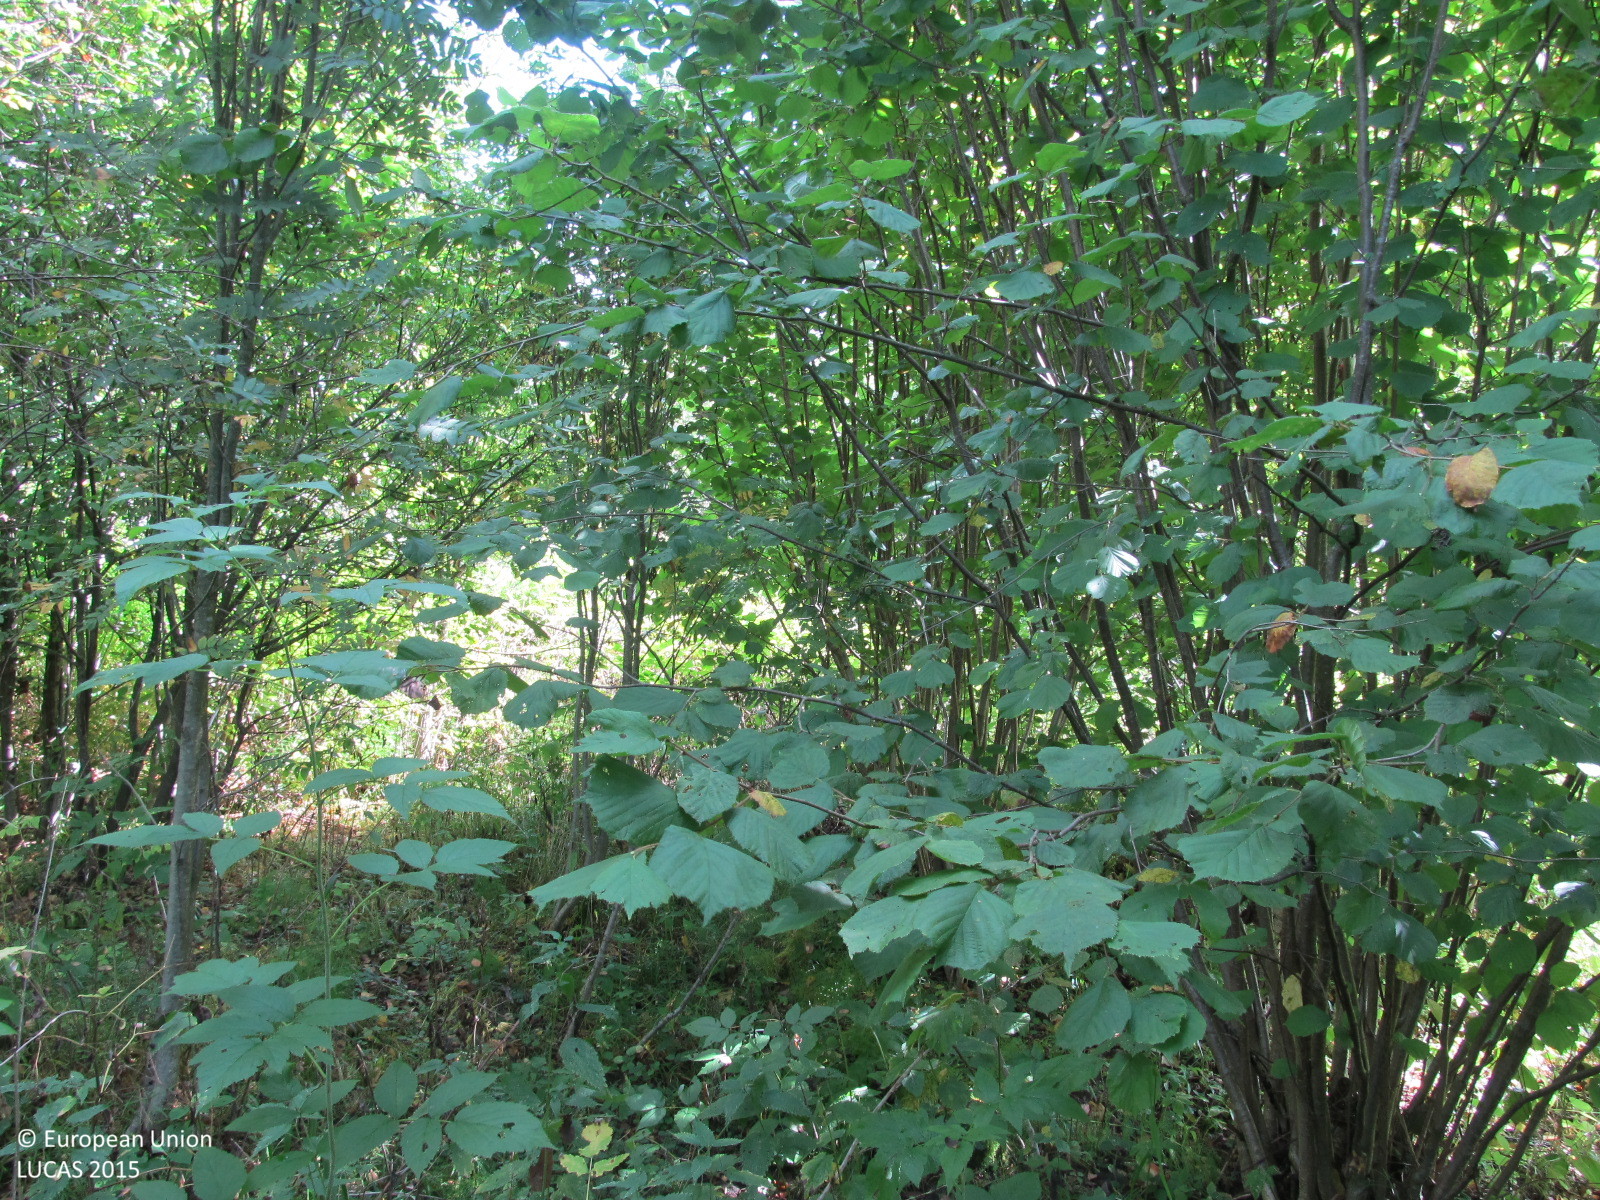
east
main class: Woodland
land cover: Broadleaved woodland
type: non-riverine alder, birch or aspen forest
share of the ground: > 75 %
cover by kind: broadleaved forest trees 80 %, shrubs 10 %, herbaceous plants 10 %
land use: Forestry
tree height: < 5 m
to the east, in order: Broadleaved woodland; Shrubland with sparse tree cover; Ditches and canals; Broadleaved woodland; Grassland without tree/shrub cover
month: September
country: LT
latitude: 55.6223
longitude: 22.5591
